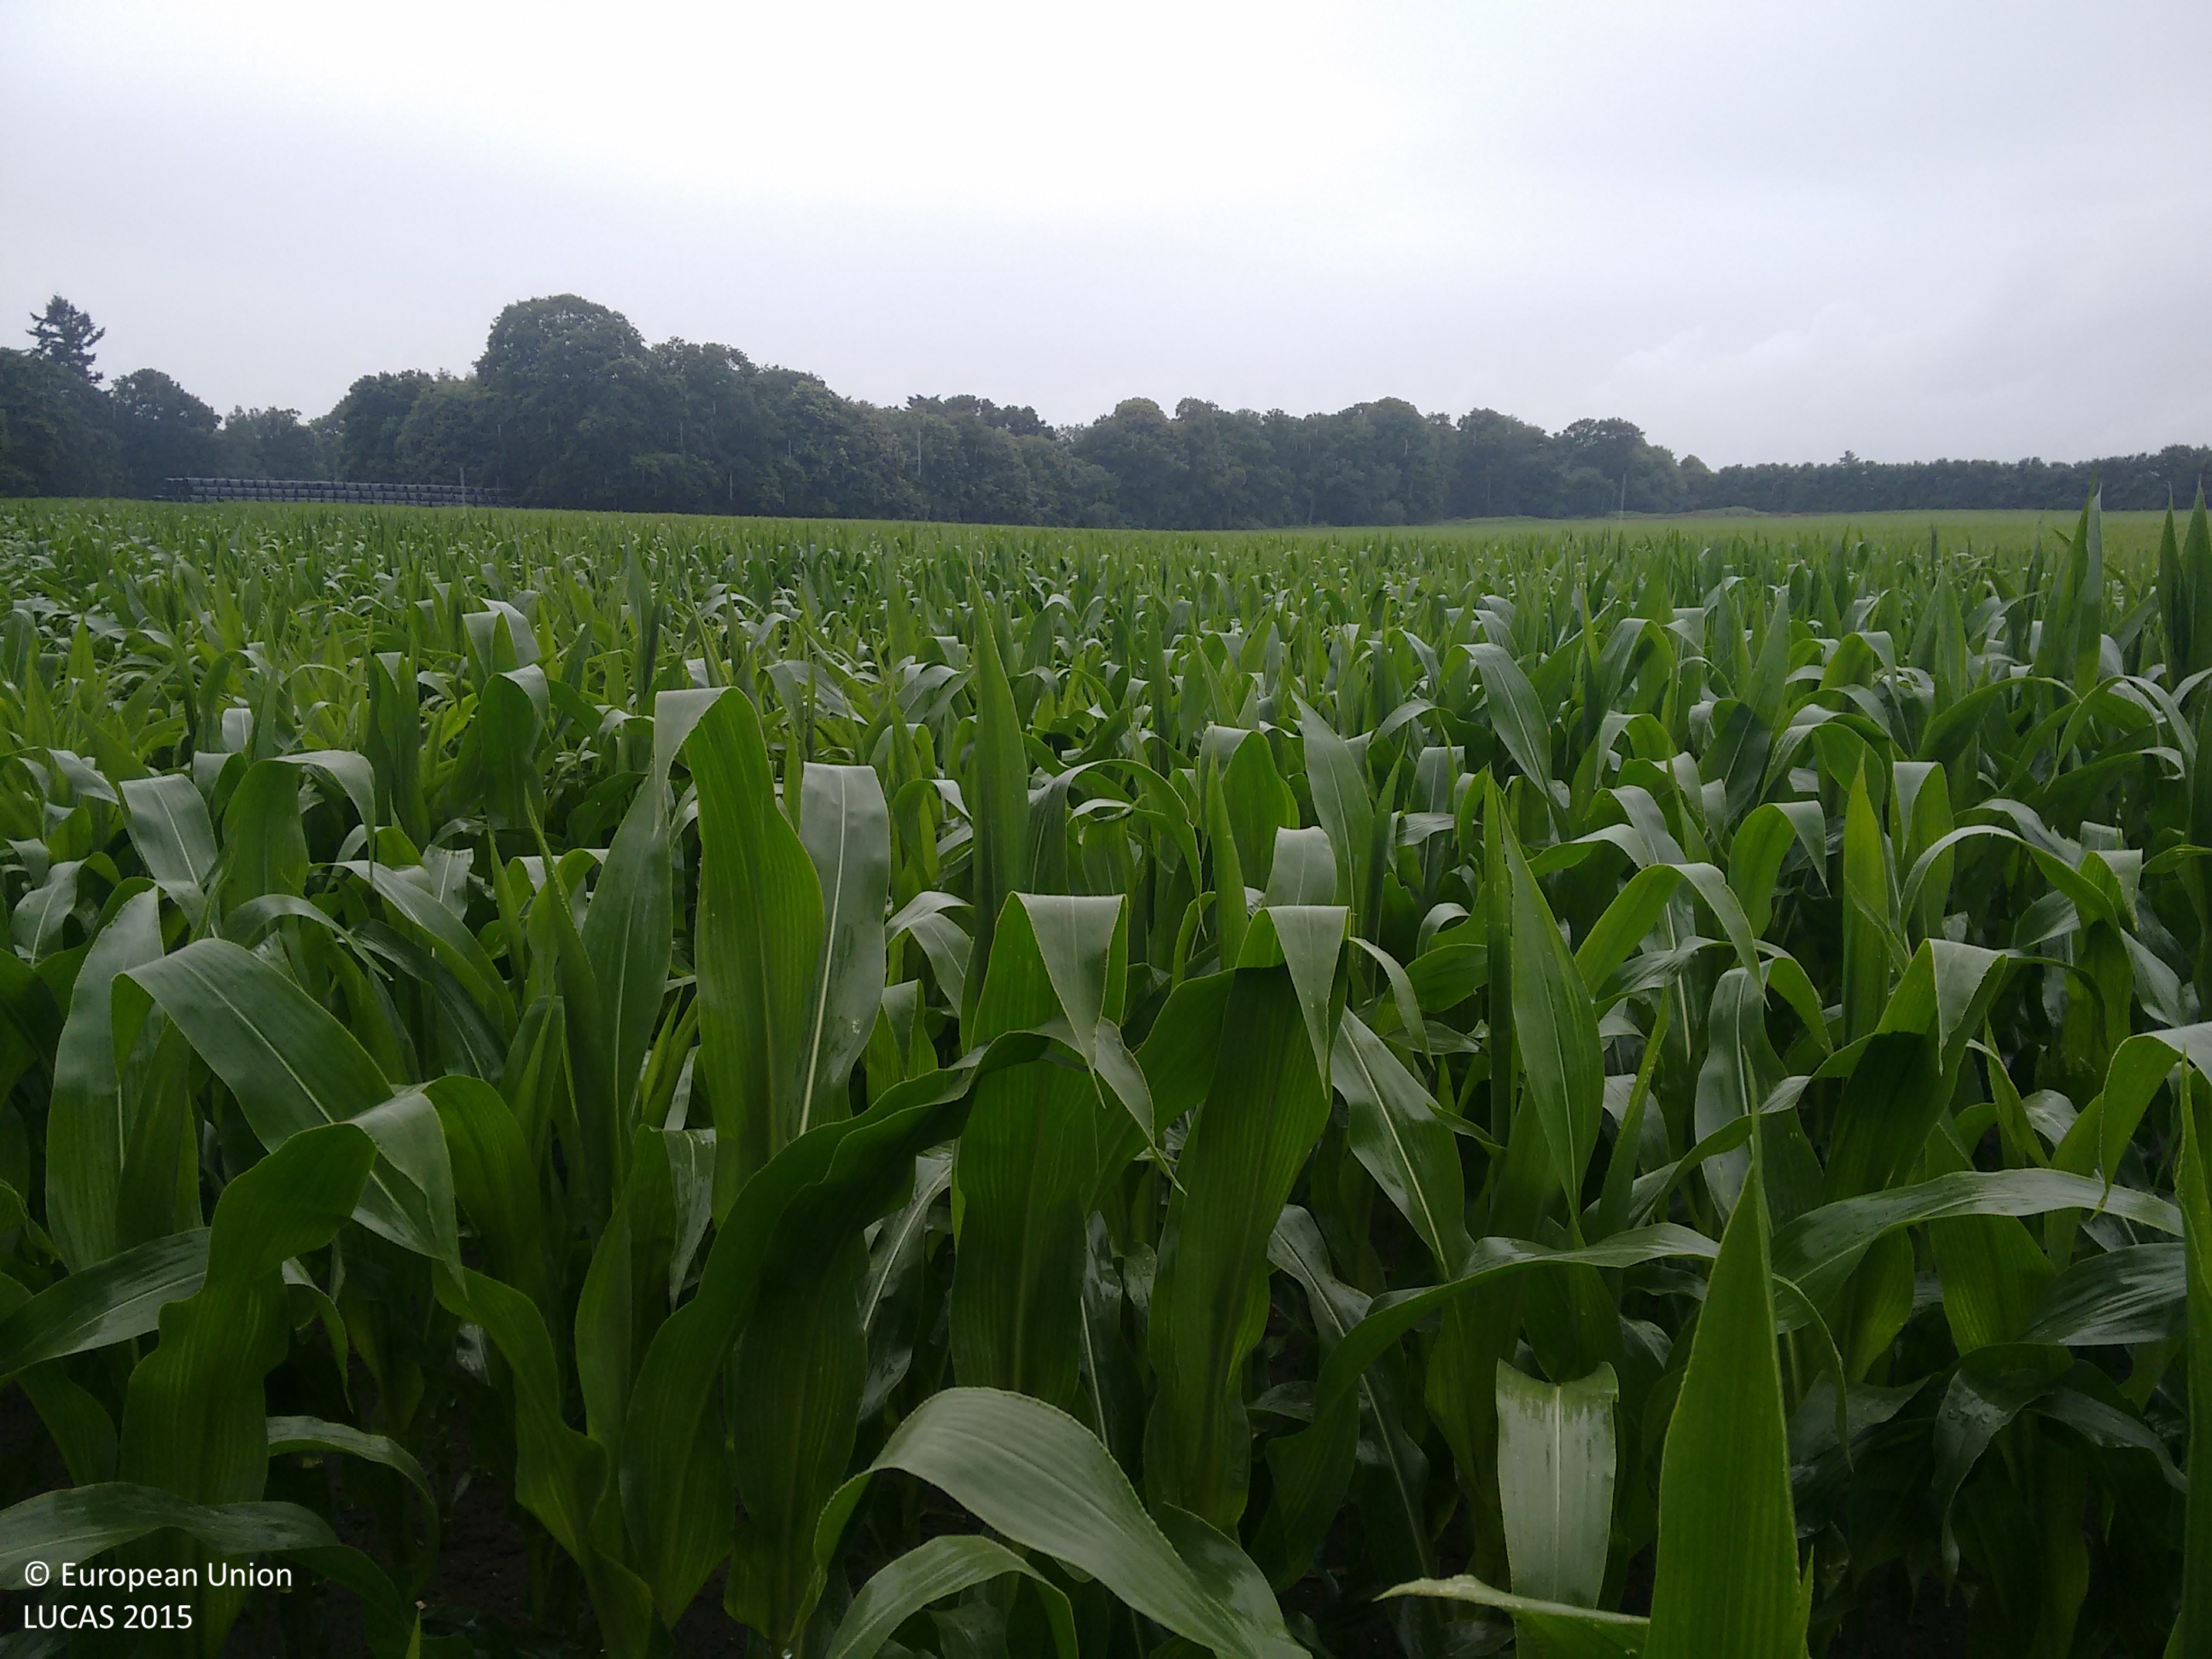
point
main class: Cropland
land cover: Maize
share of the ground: > 75 %
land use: Agriculture (excluding fallow land and kitchen gardens)
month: July
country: GB
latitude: 51.0652
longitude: -0.8158
